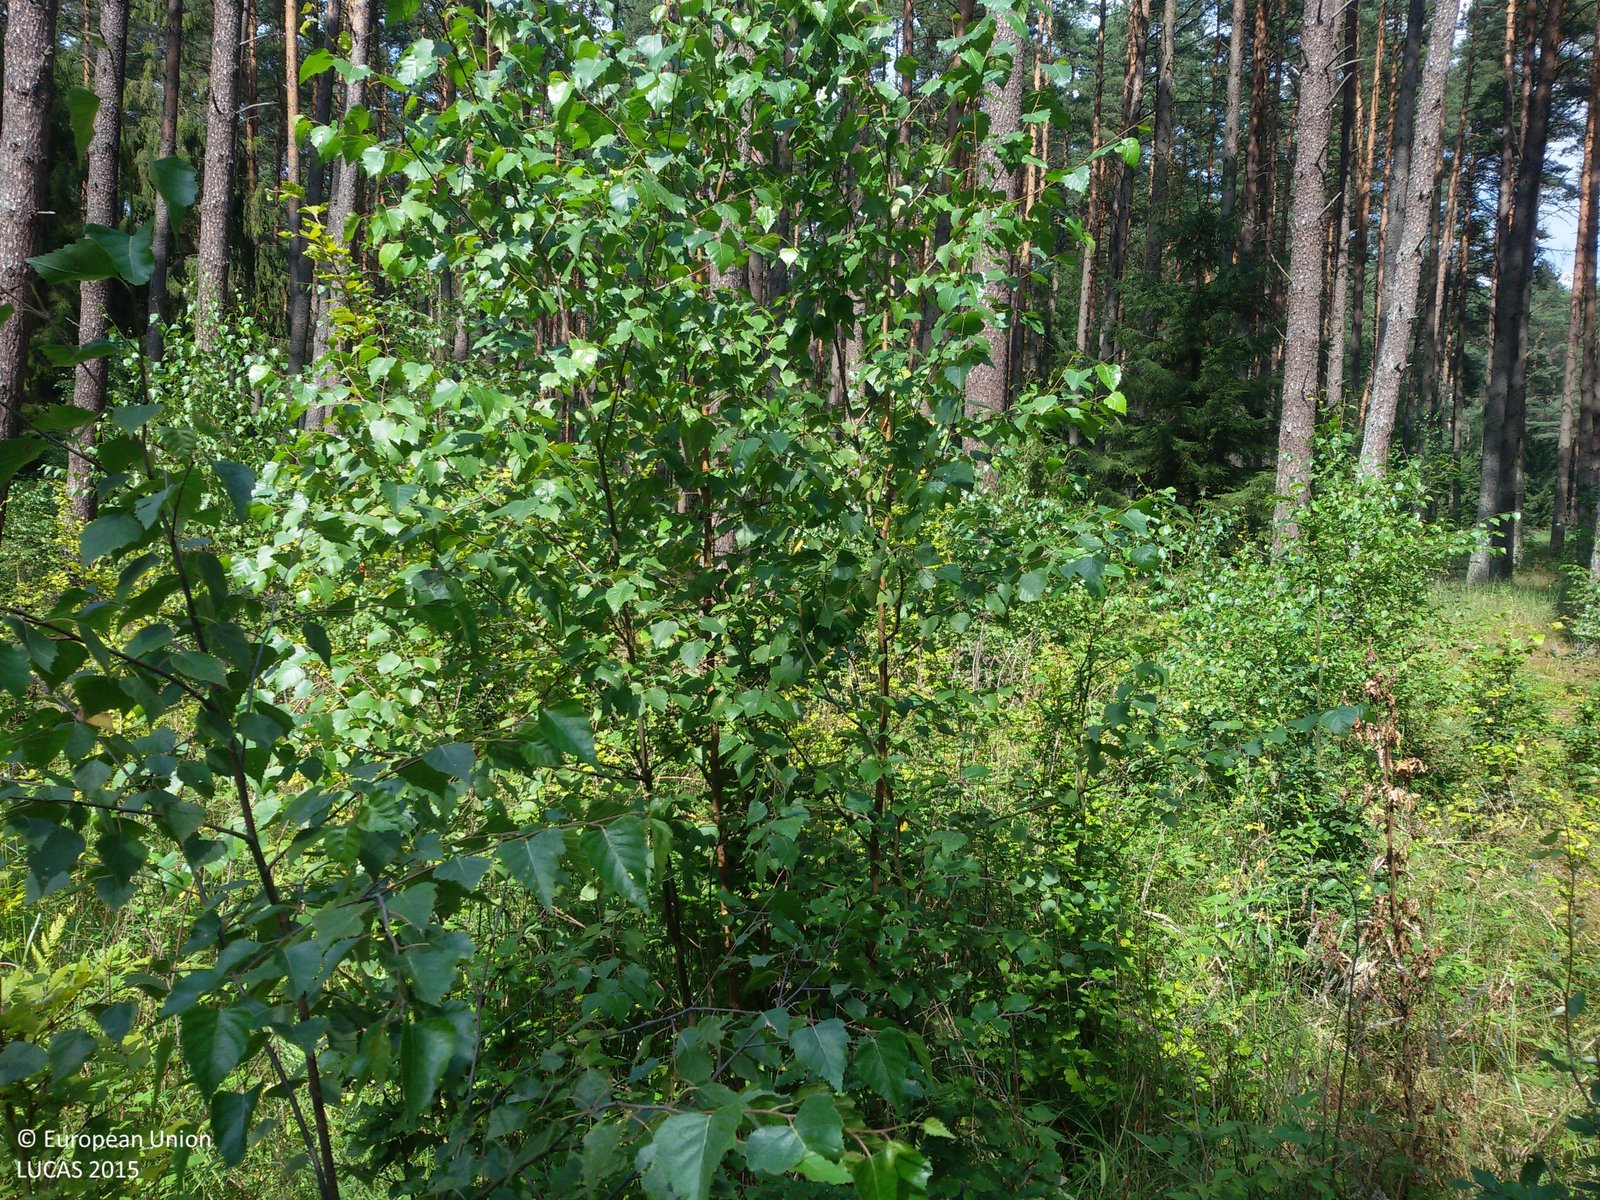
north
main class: Woodland
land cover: Broadleaved woodland
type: mesophytic deciduous forest
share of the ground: > 75 %
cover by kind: broadleaved forest trees 75 %, herbaceous plants 25 %
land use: Forestry
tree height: > 5 m
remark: Nursery
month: August
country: PL
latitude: 53.7308
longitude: 17.7587
